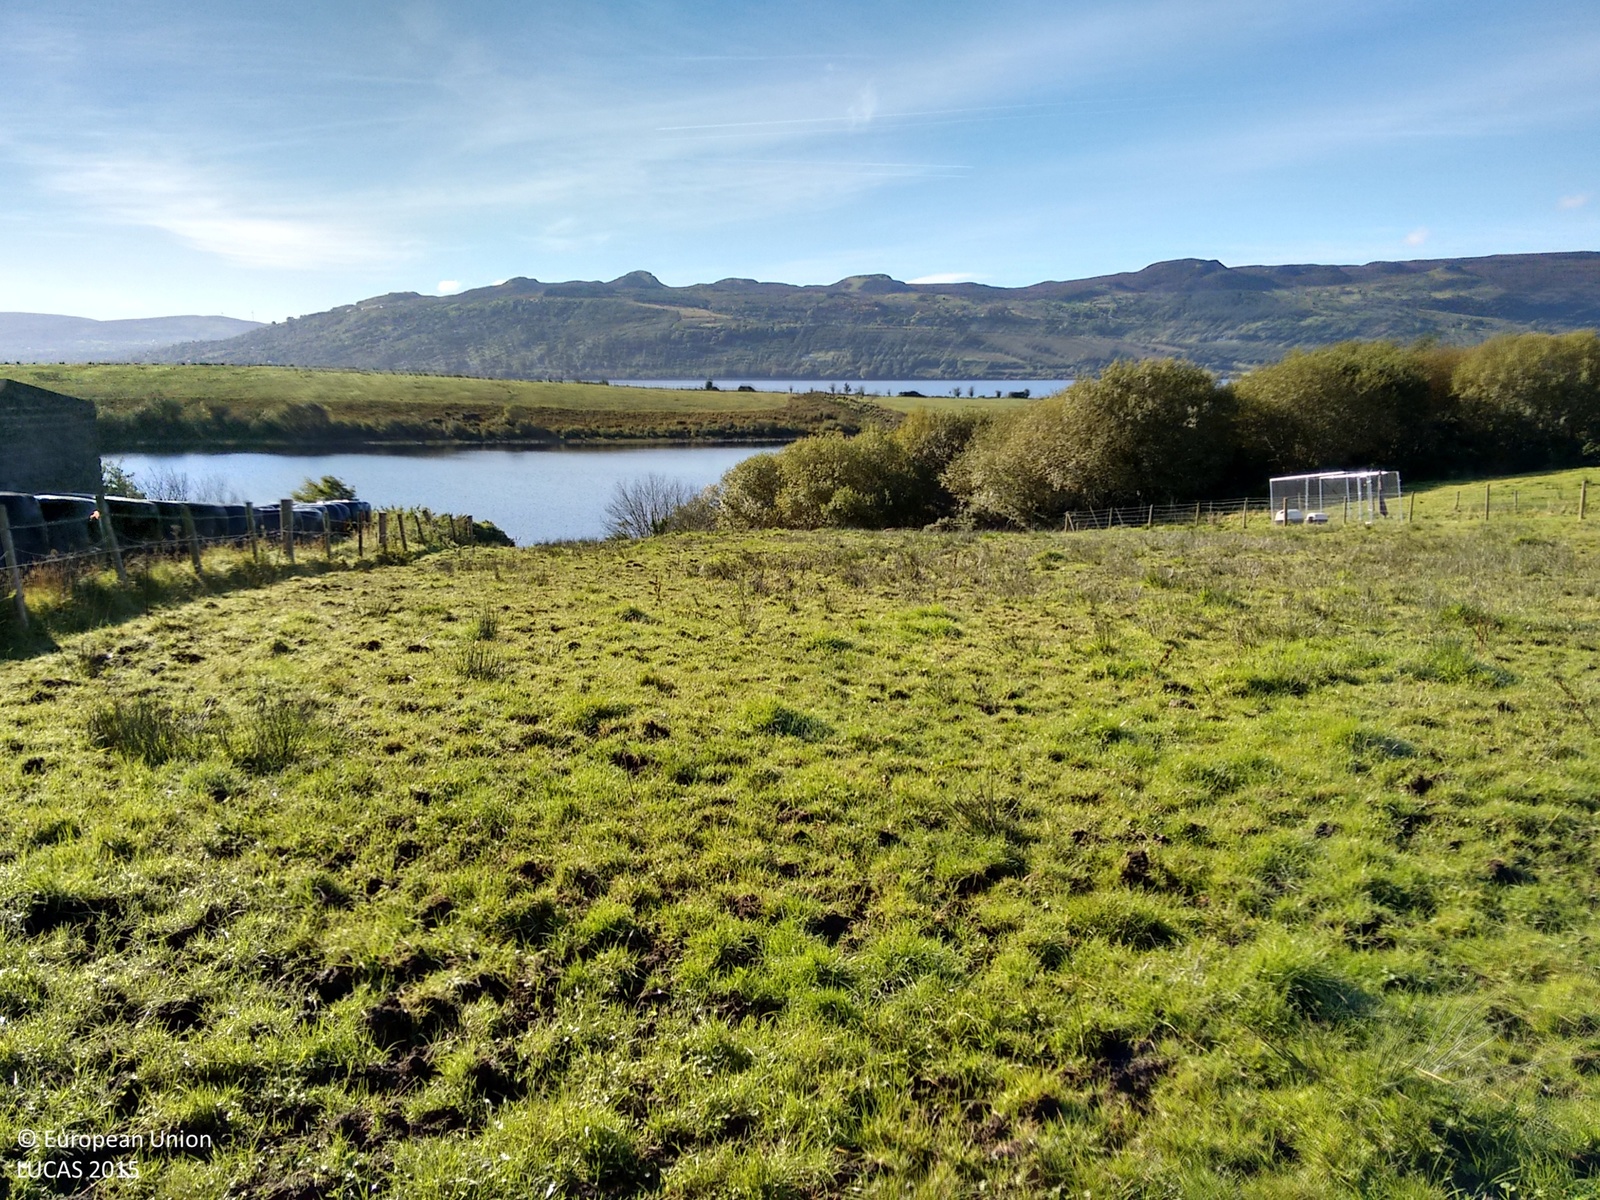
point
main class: Grassland
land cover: Grassland without tree/shrub cover
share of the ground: > 75 %
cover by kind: herbaceous plants 100 %
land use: Agriculture (excluding fallow land and kitchen gardens)
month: October
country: GB
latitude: 54.4341
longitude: -8.1384
